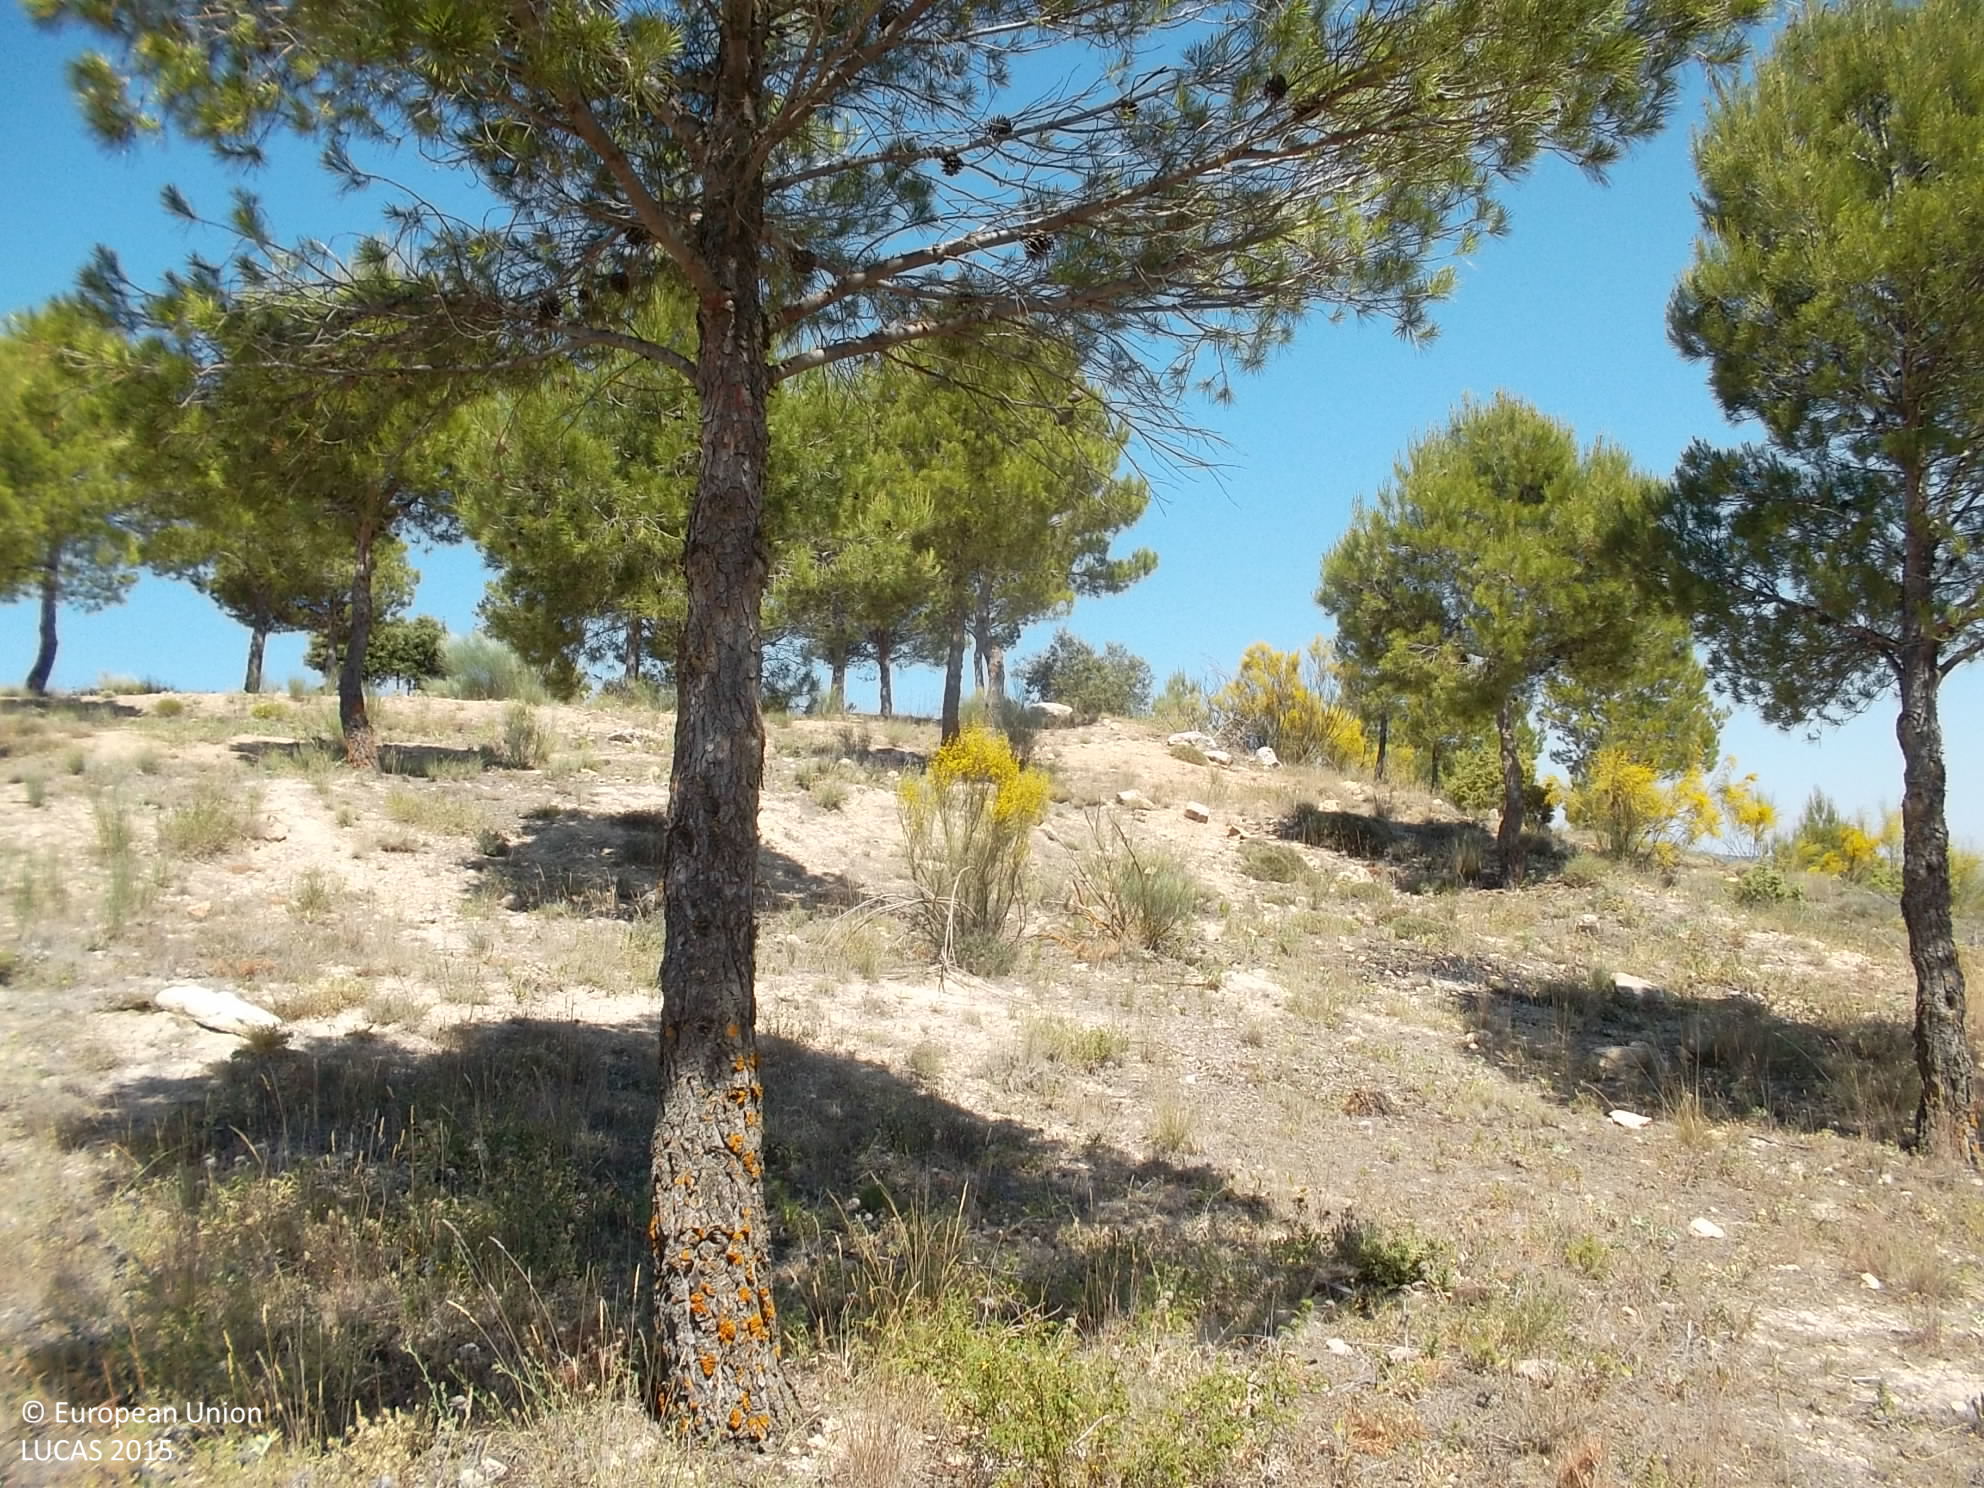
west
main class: Woodland
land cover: Pine dominated coniferous woodland
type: alpine coniferous forest
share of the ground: 25 - 50 %
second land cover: Spontaneously vegetated surfaces
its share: > 75 %
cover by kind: herbaceous plants 50 %, coniferous forest trees 30 %, unconsolidated bare surface 20 %
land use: Forestry
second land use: Agriculture (excluding fallow land and kitchen gardens)
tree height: > 5 m
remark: Clear cut
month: June
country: ES
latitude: 37.7048
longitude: -3.3225
